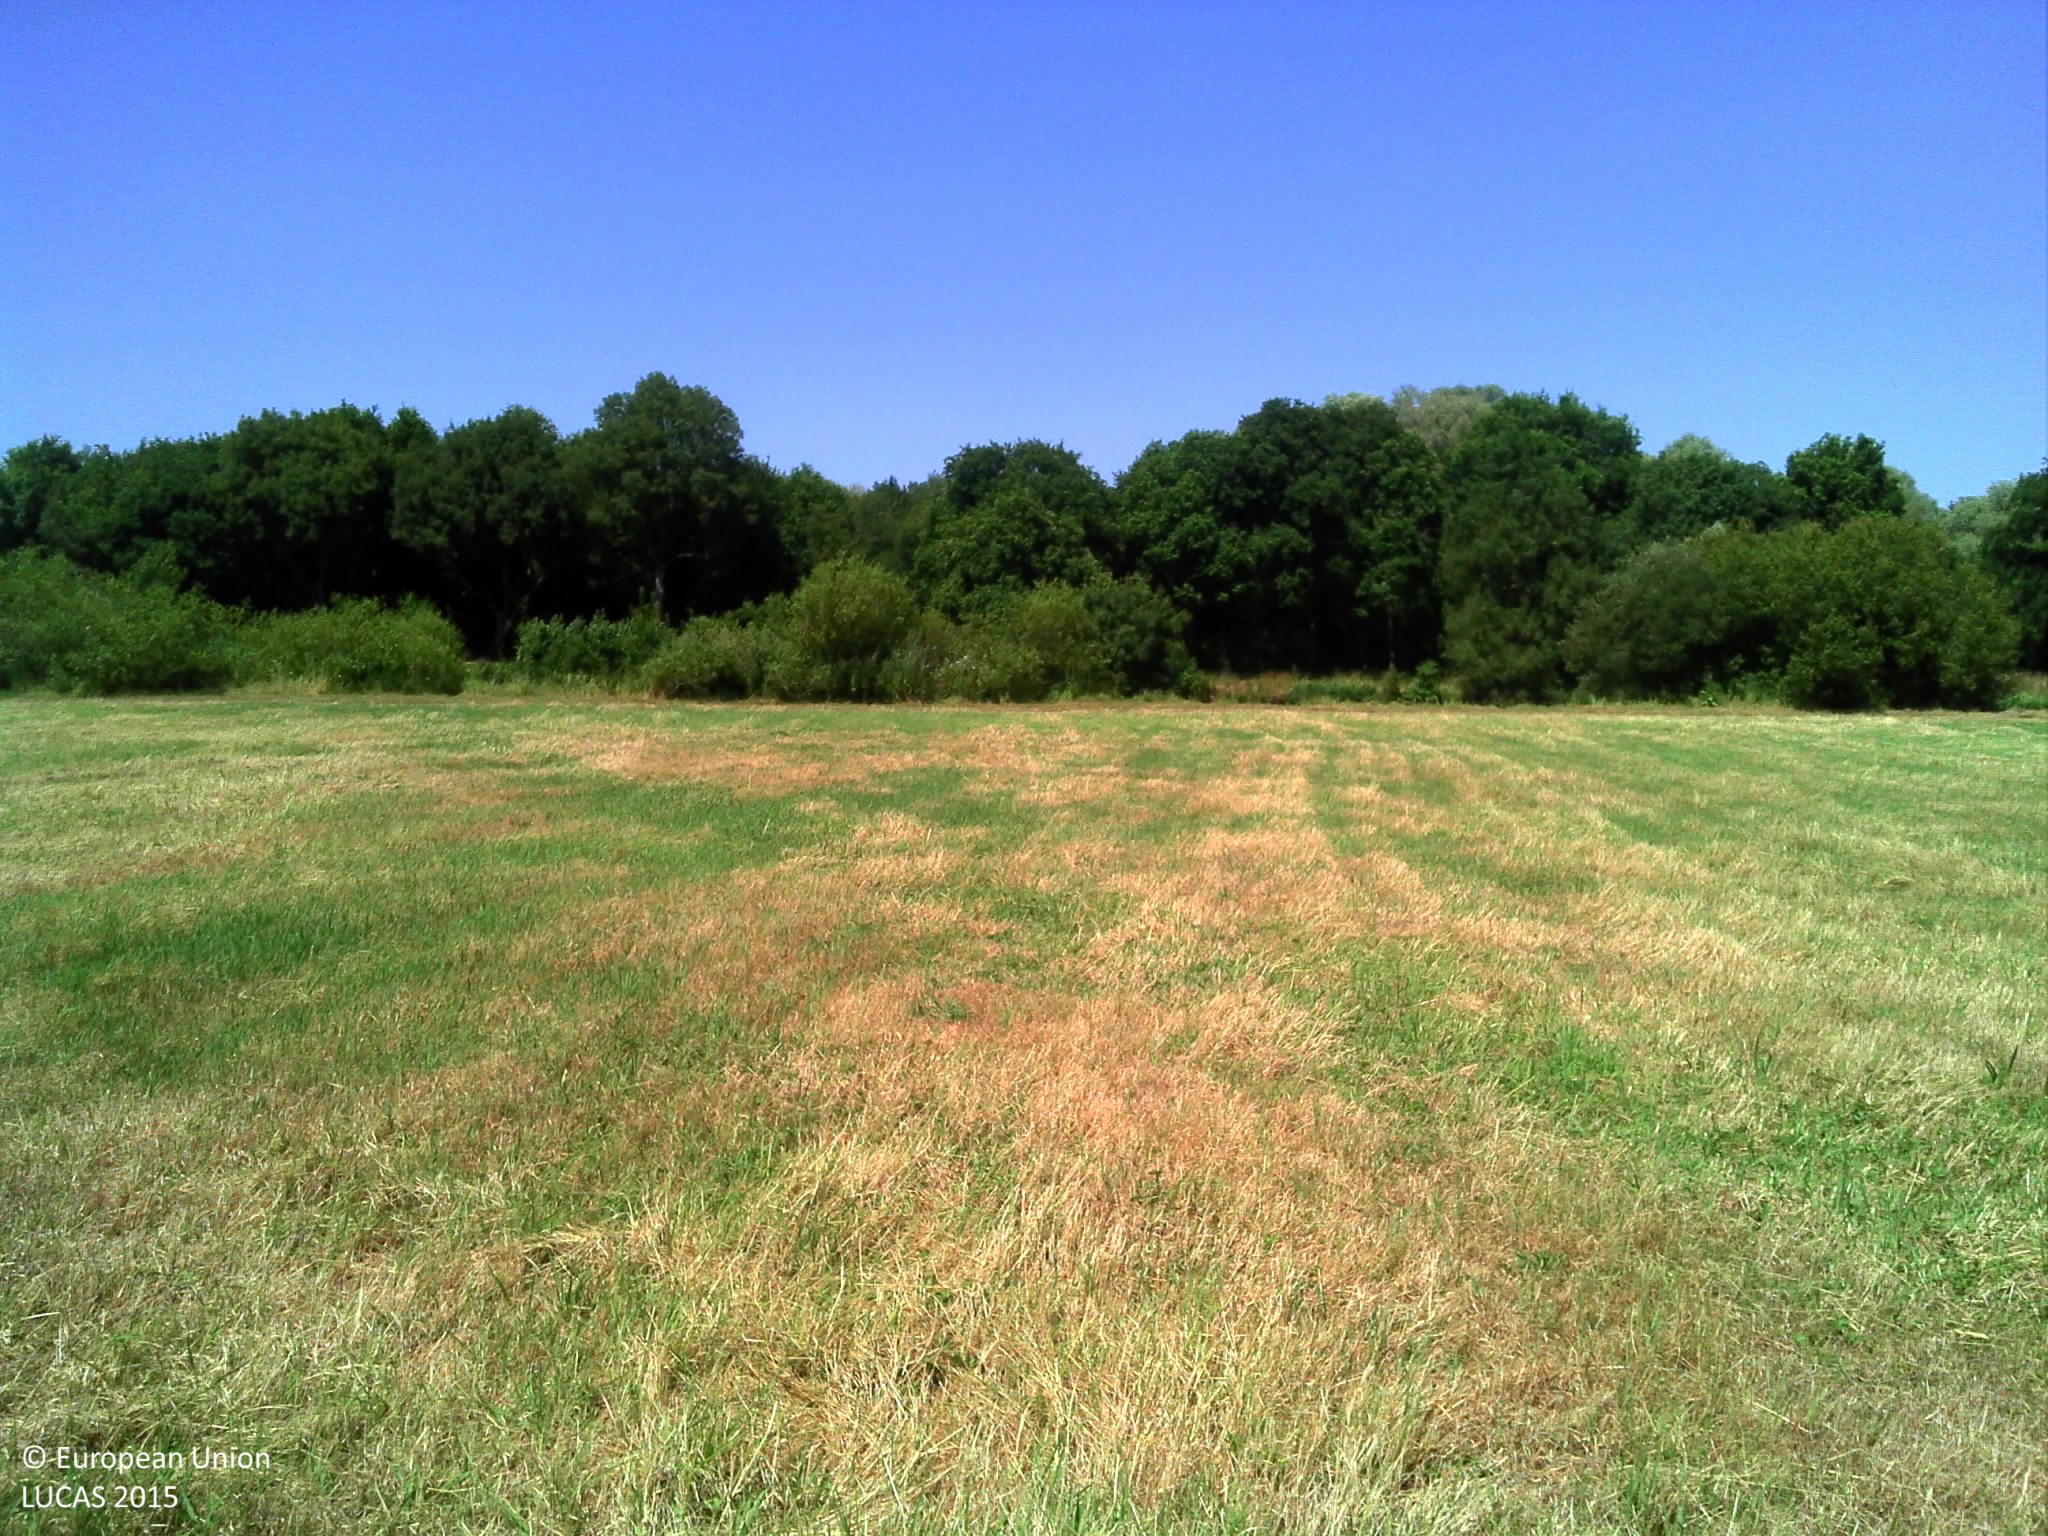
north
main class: Grassland
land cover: Grassland without tree/shrub cover
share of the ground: > 75 %
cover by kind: herbaceous plants 100 %
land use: Agriculture (excluding fallow land and kitchen gardens)
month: July
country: FR
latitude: 47.6718
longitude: -2.0242
